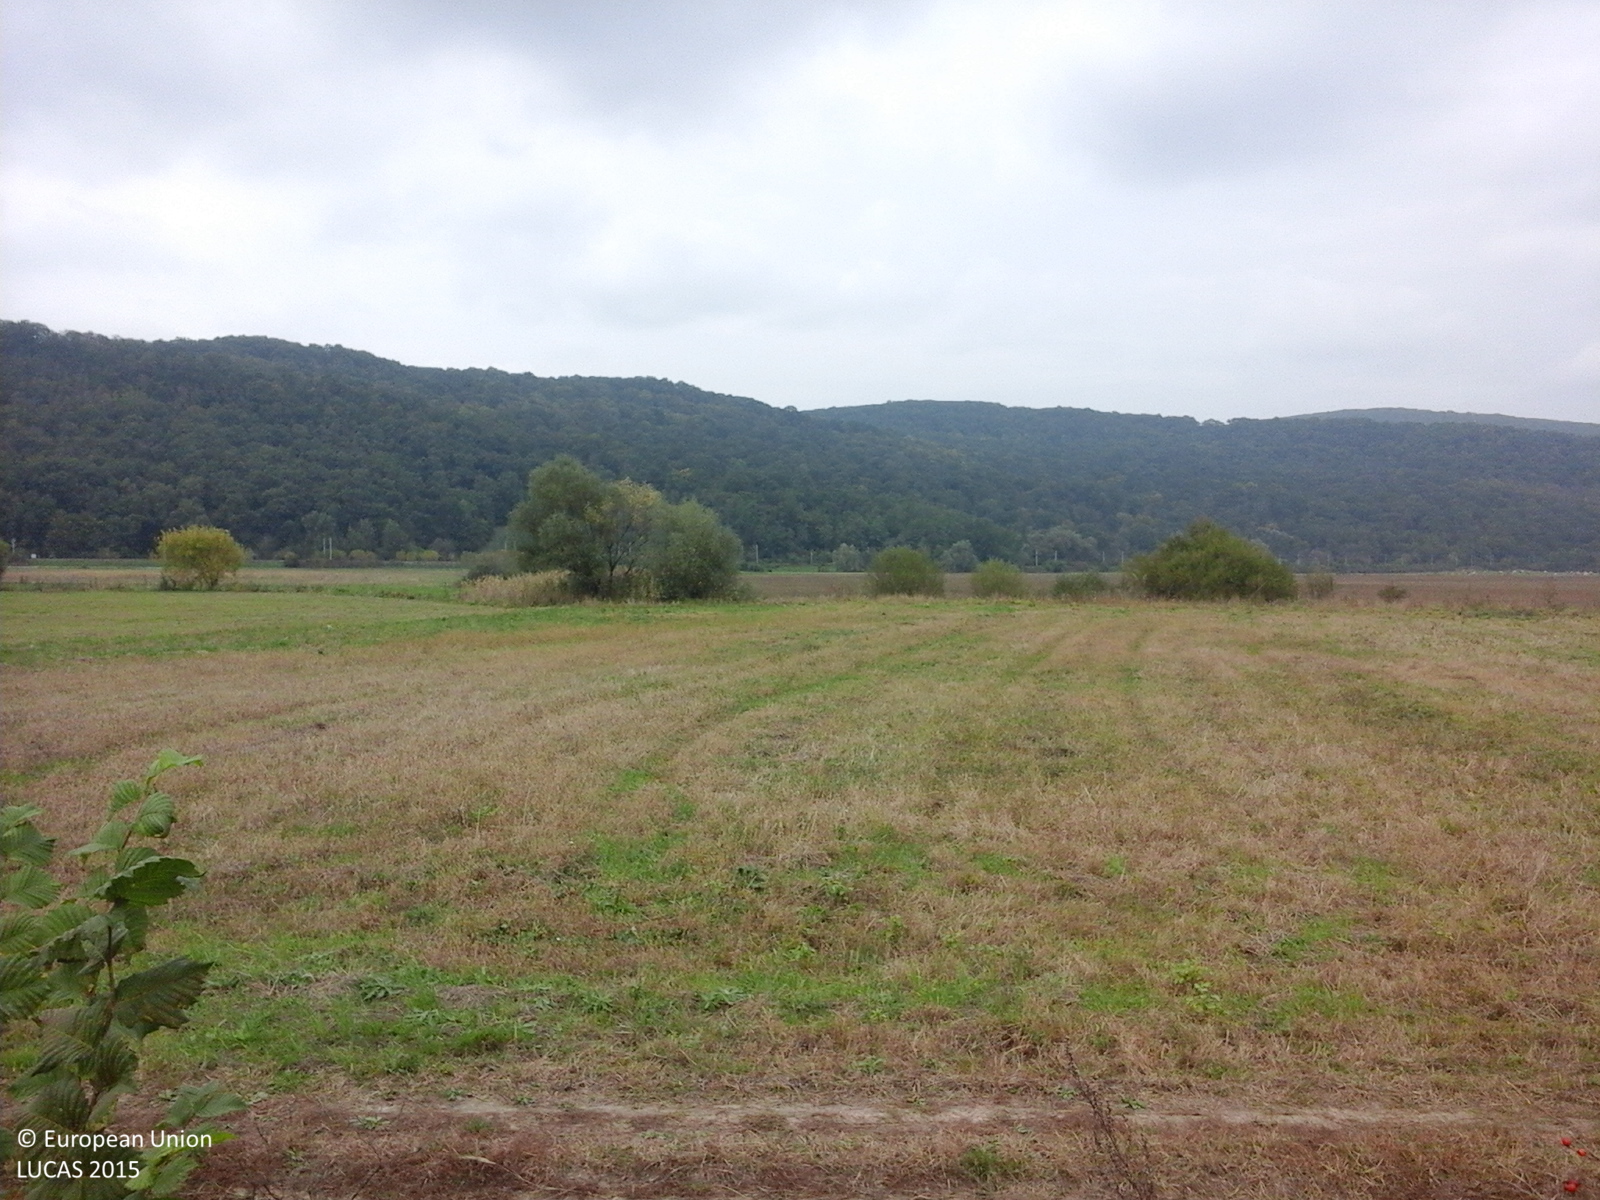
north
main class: Grassland
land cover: Spontaneously vegetated surfaces
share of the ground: > 75 %
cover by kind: herbaceous plants 100 %
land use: Fallow land
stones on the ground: < 10 %
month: October
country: RO
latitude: 46.0078
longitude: 25.3270
